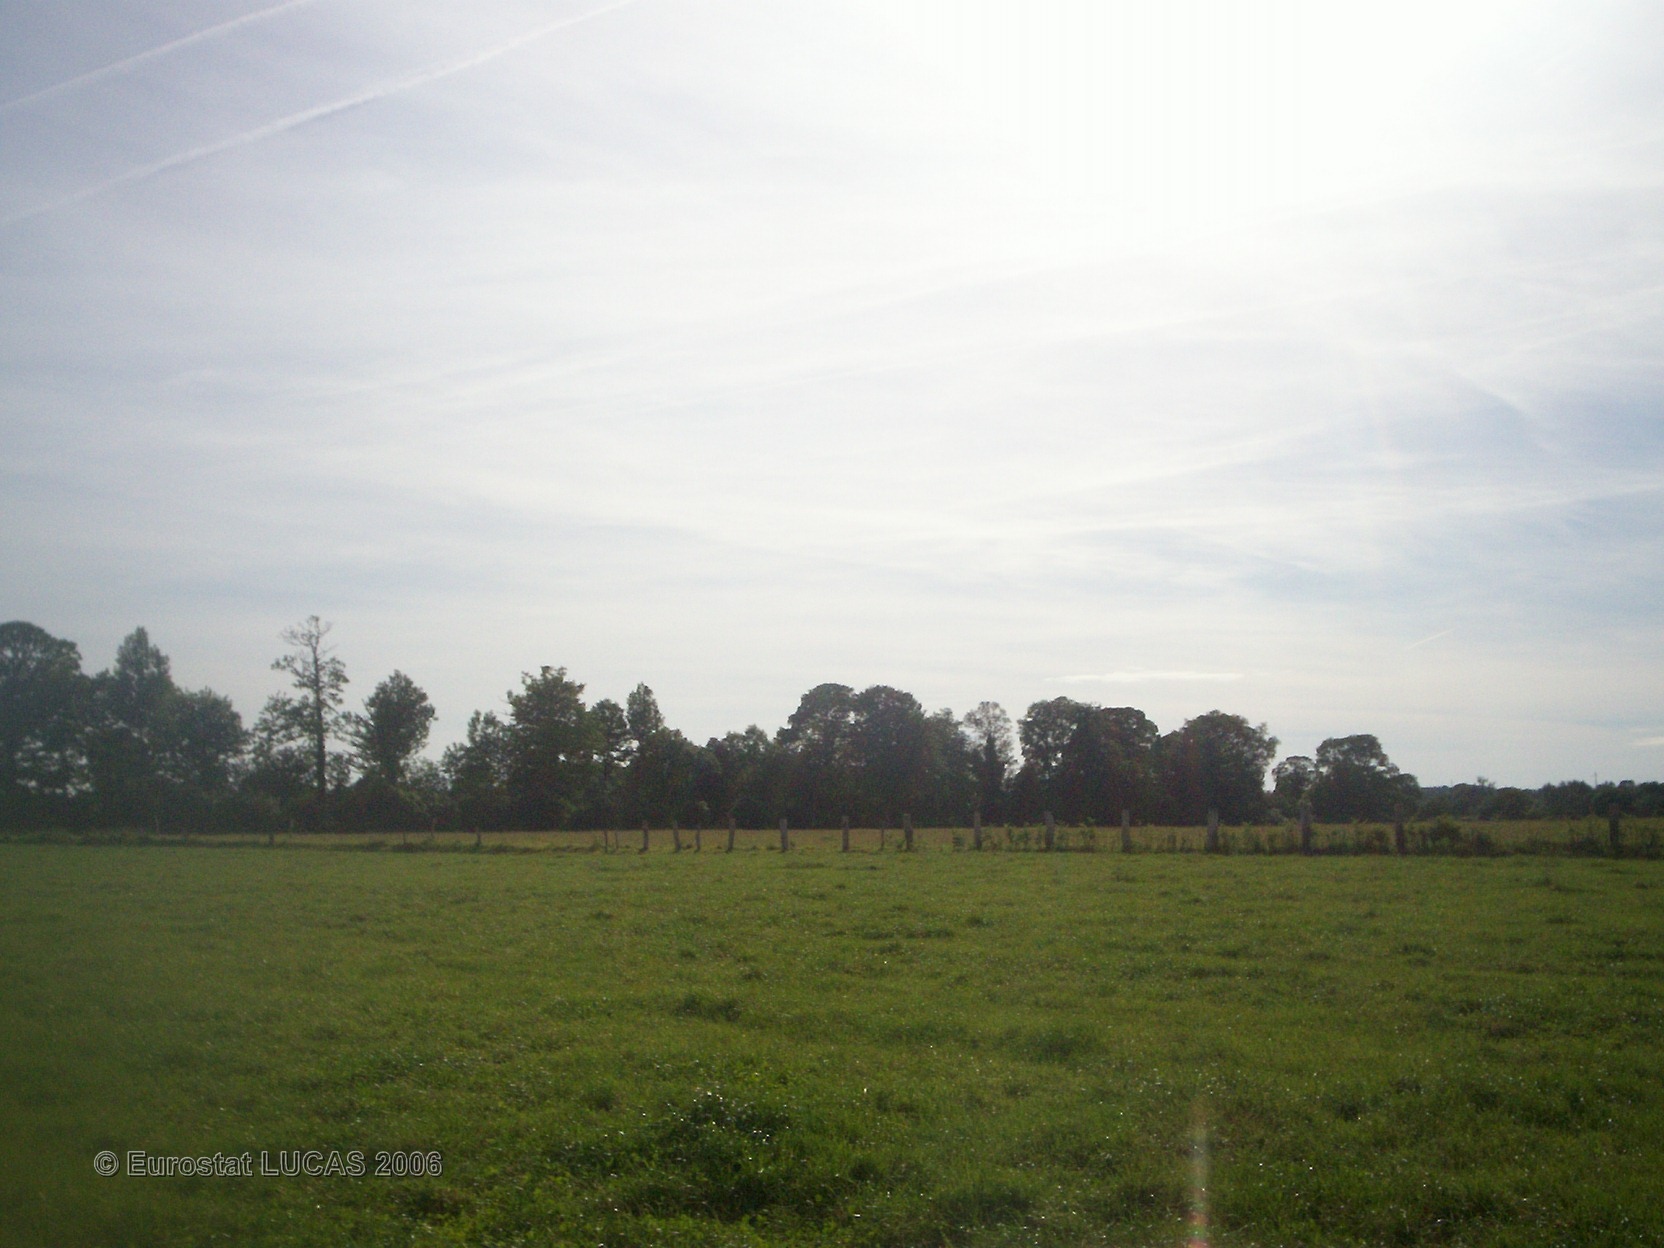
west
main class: Grassland
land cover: Grassland without tree/shrub cover
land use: Agriculture (excluding fallow land and kitchen gardens)
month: June
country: FR
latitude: 48.5364
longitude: -1.2442
